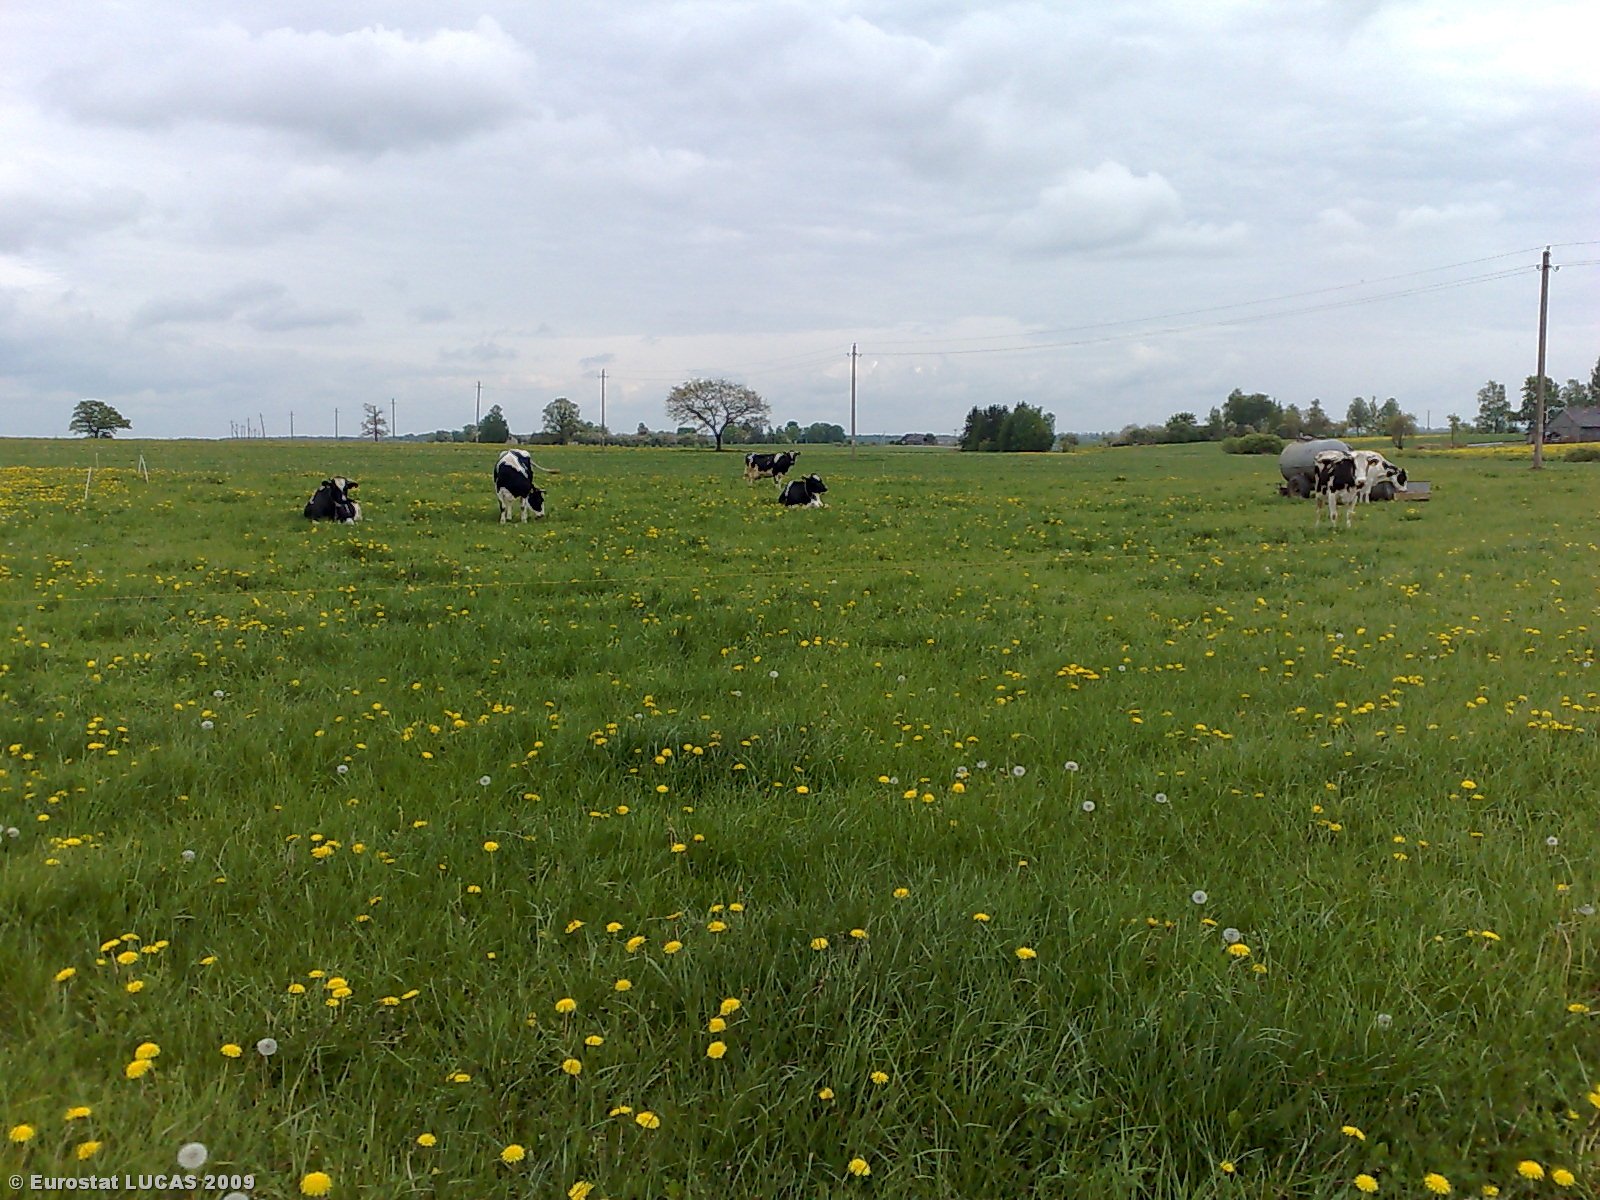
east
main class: Grassland
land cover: Grassland without tree/shrub cover
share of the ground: > 75 %
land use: Agriculture (excluding fallow land and kitchen gardens)
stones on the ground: < 10 %
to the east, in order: Grassland without tree/shrub cover; Electric lines; Grassland without tree/shrub cover; Tracks; Grassland without tree/shrub cover
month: May
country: LT
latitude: 55.5367
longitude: 23.7263
